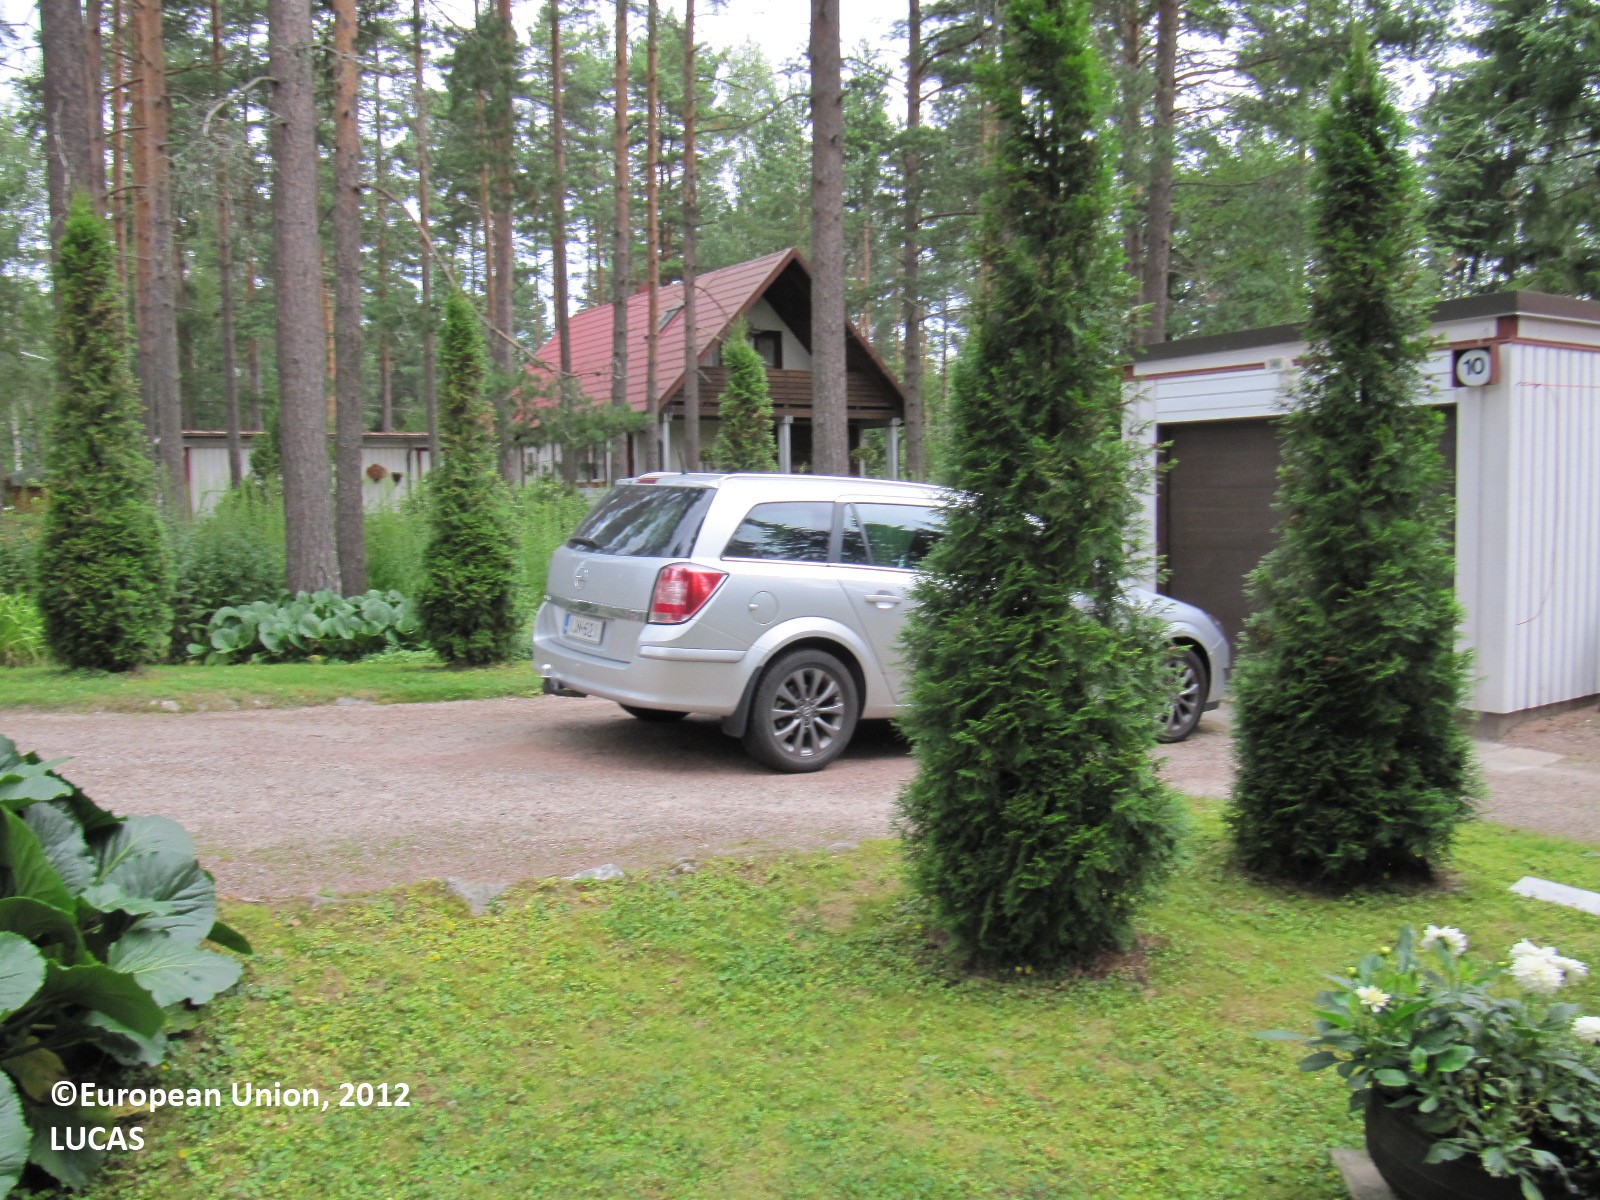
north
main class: Grassland
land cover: Grassland with sparse tree/shrub cover
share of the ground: > 75 %
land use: Residential
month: August
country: FI
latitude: 60.4045
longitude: 23.1323
